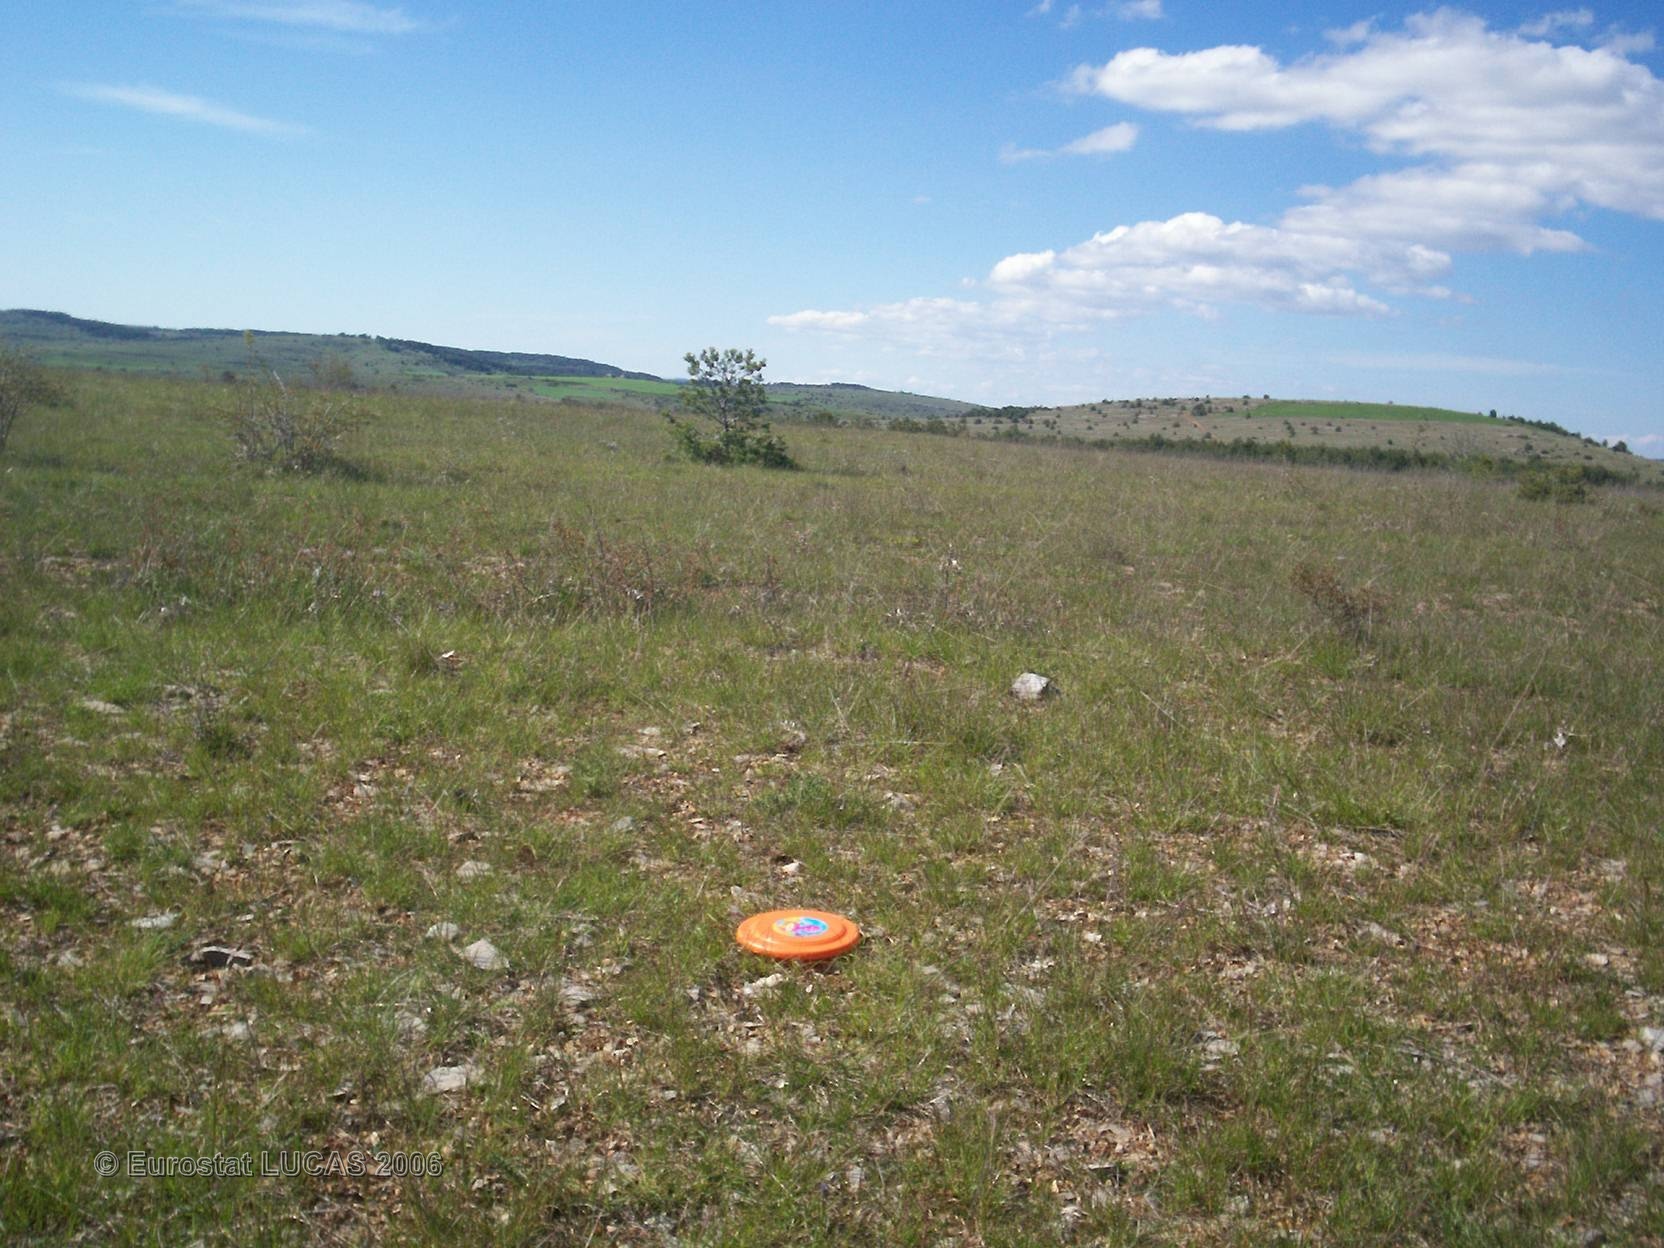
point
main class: Grassland
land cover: Grassland without tree/shrub cover
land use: Agriculture (excluding fallow land and kitchen gardens)
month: May
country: FR
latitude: 44.1384
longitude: 3.3689
